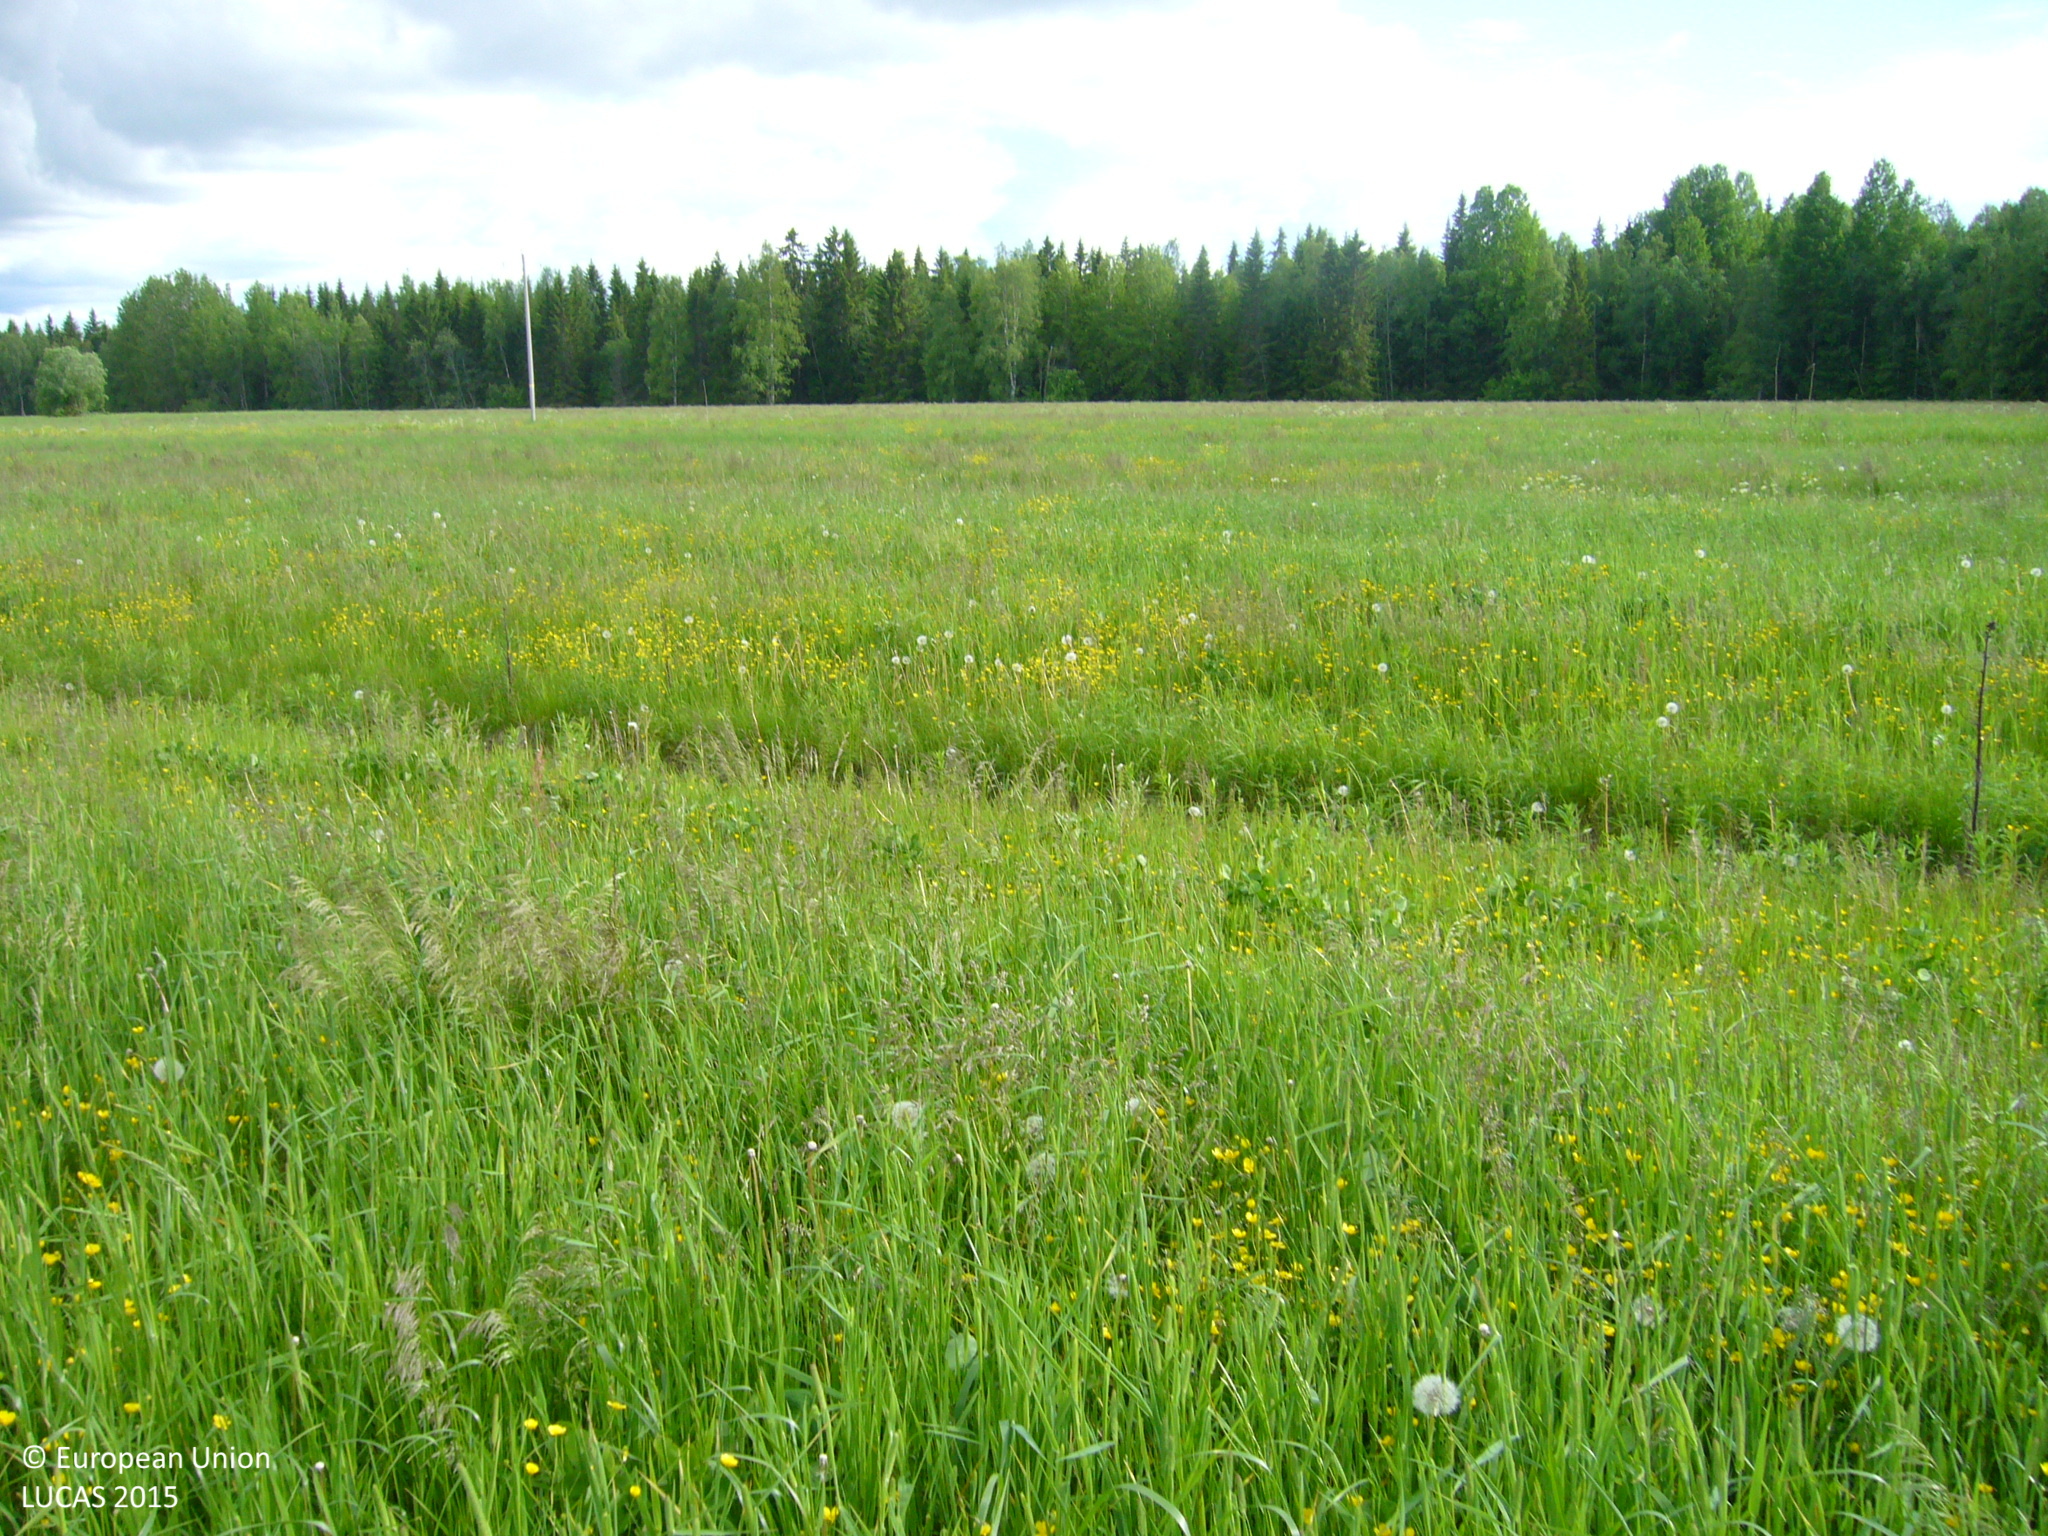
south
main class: Cropland
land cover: Temporary grasslands
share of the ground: > 75 %
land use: Agriculture (excluding fallow land and kitchen gardens)
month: June
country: FI
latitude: 63.7318
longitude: 26.3000
